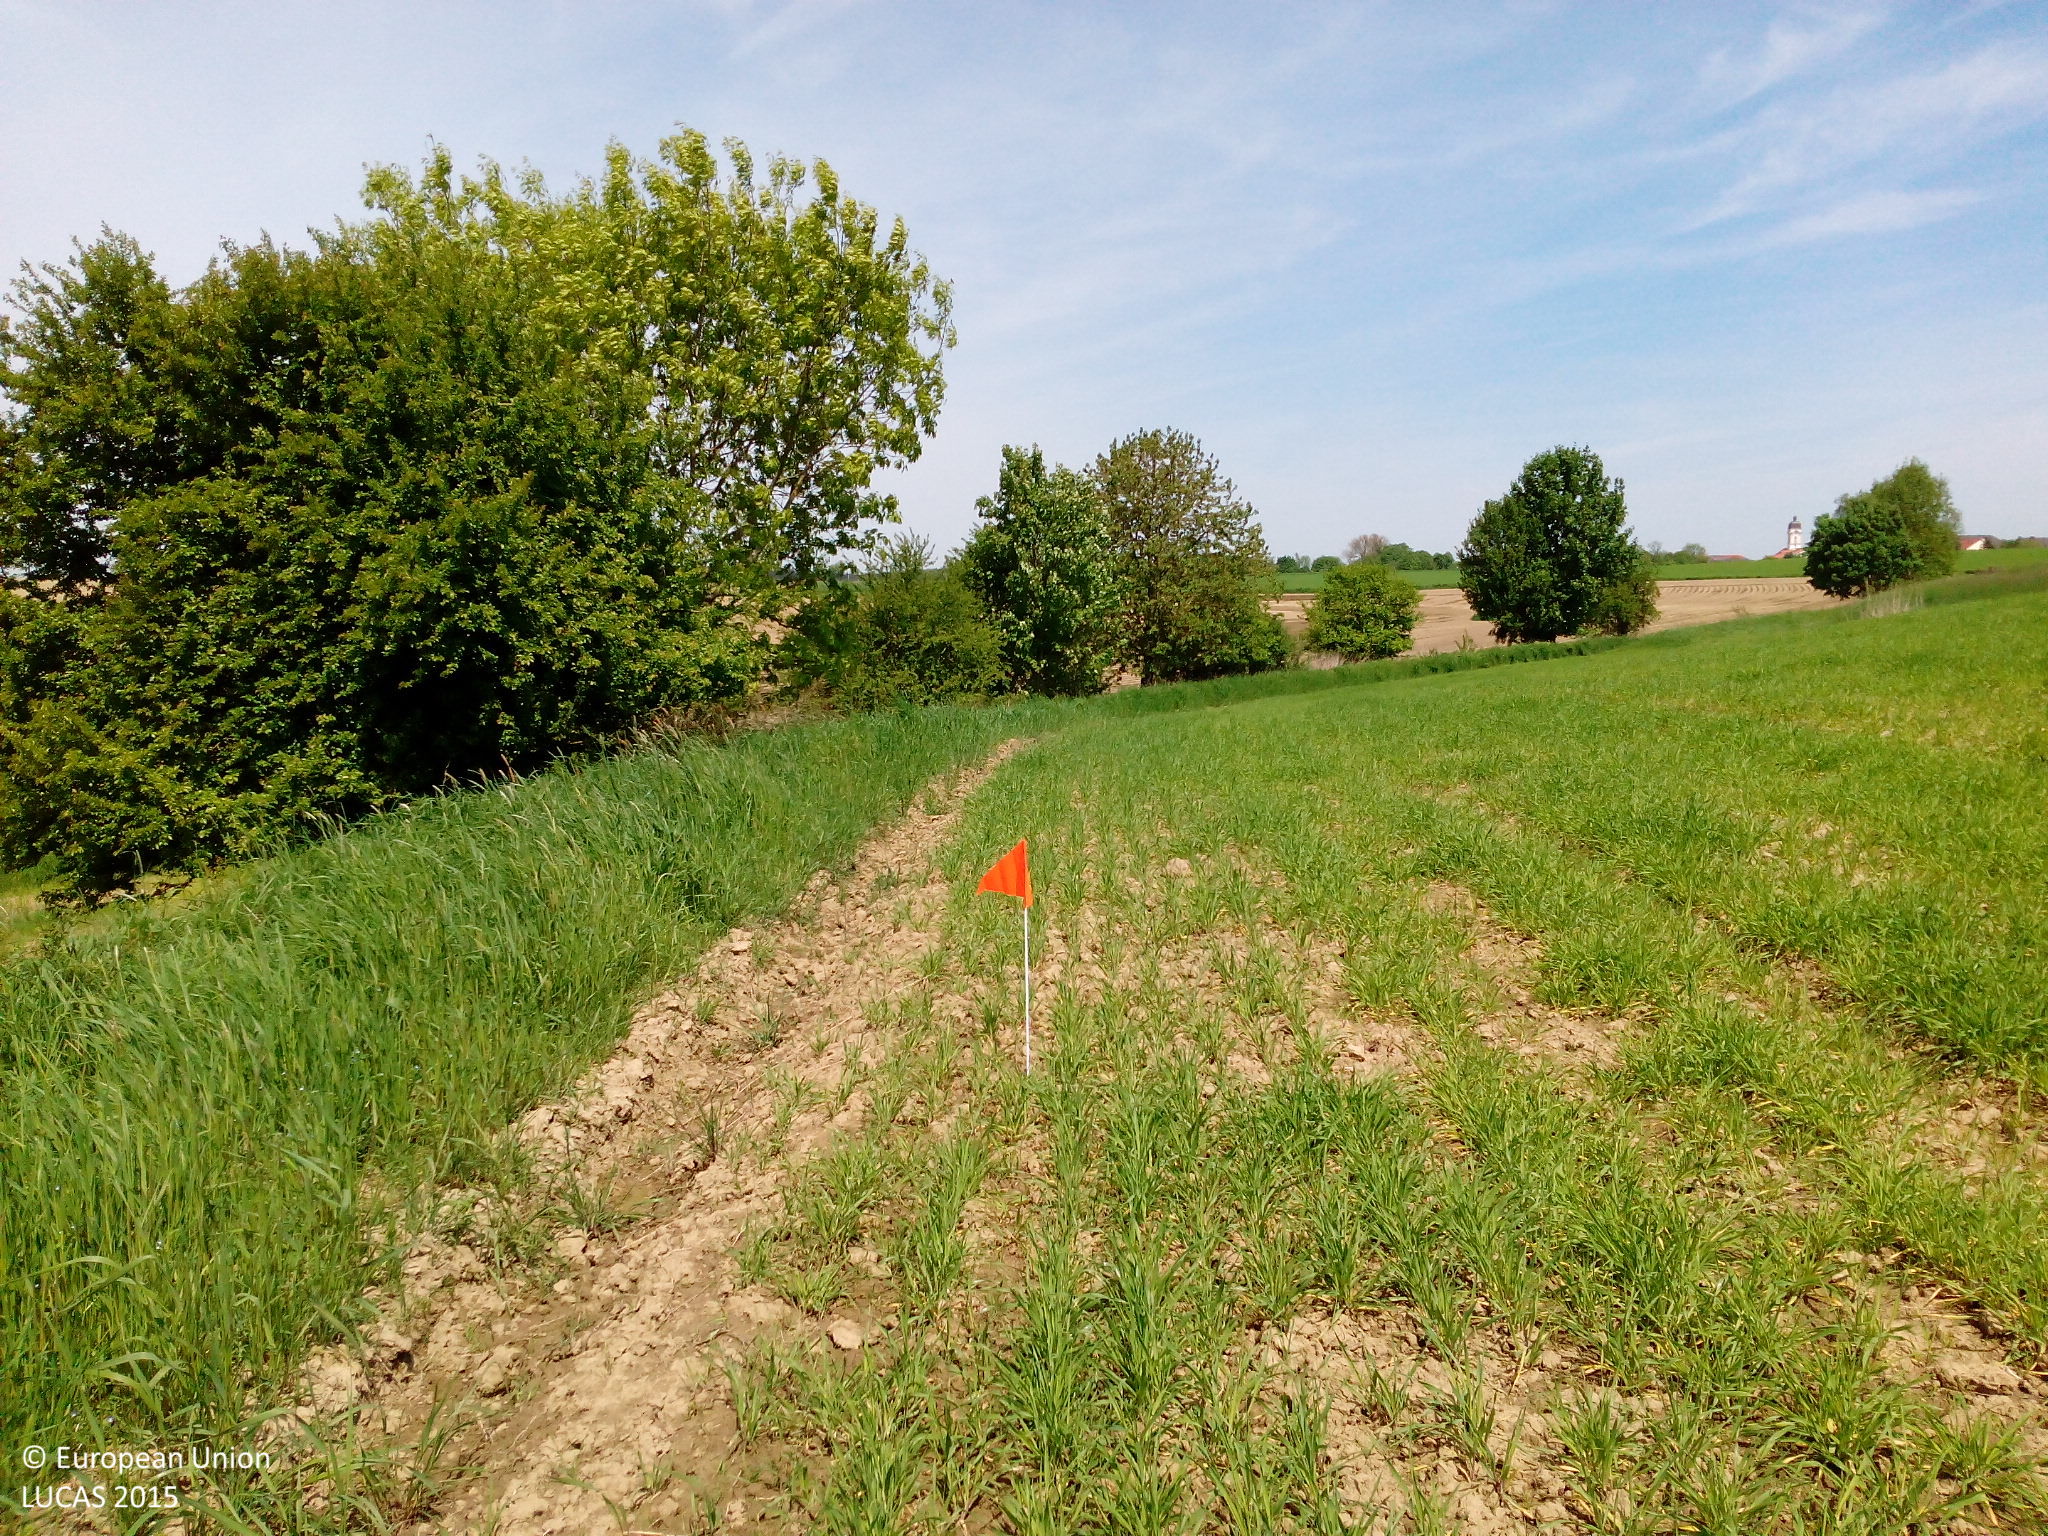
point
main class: Cropland
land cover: Barley
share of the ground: > 75 %
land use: Agriculture (excluding fallow land and kitchen gardens)
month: May
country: DE
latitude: 48.3217
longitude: 11.4693
